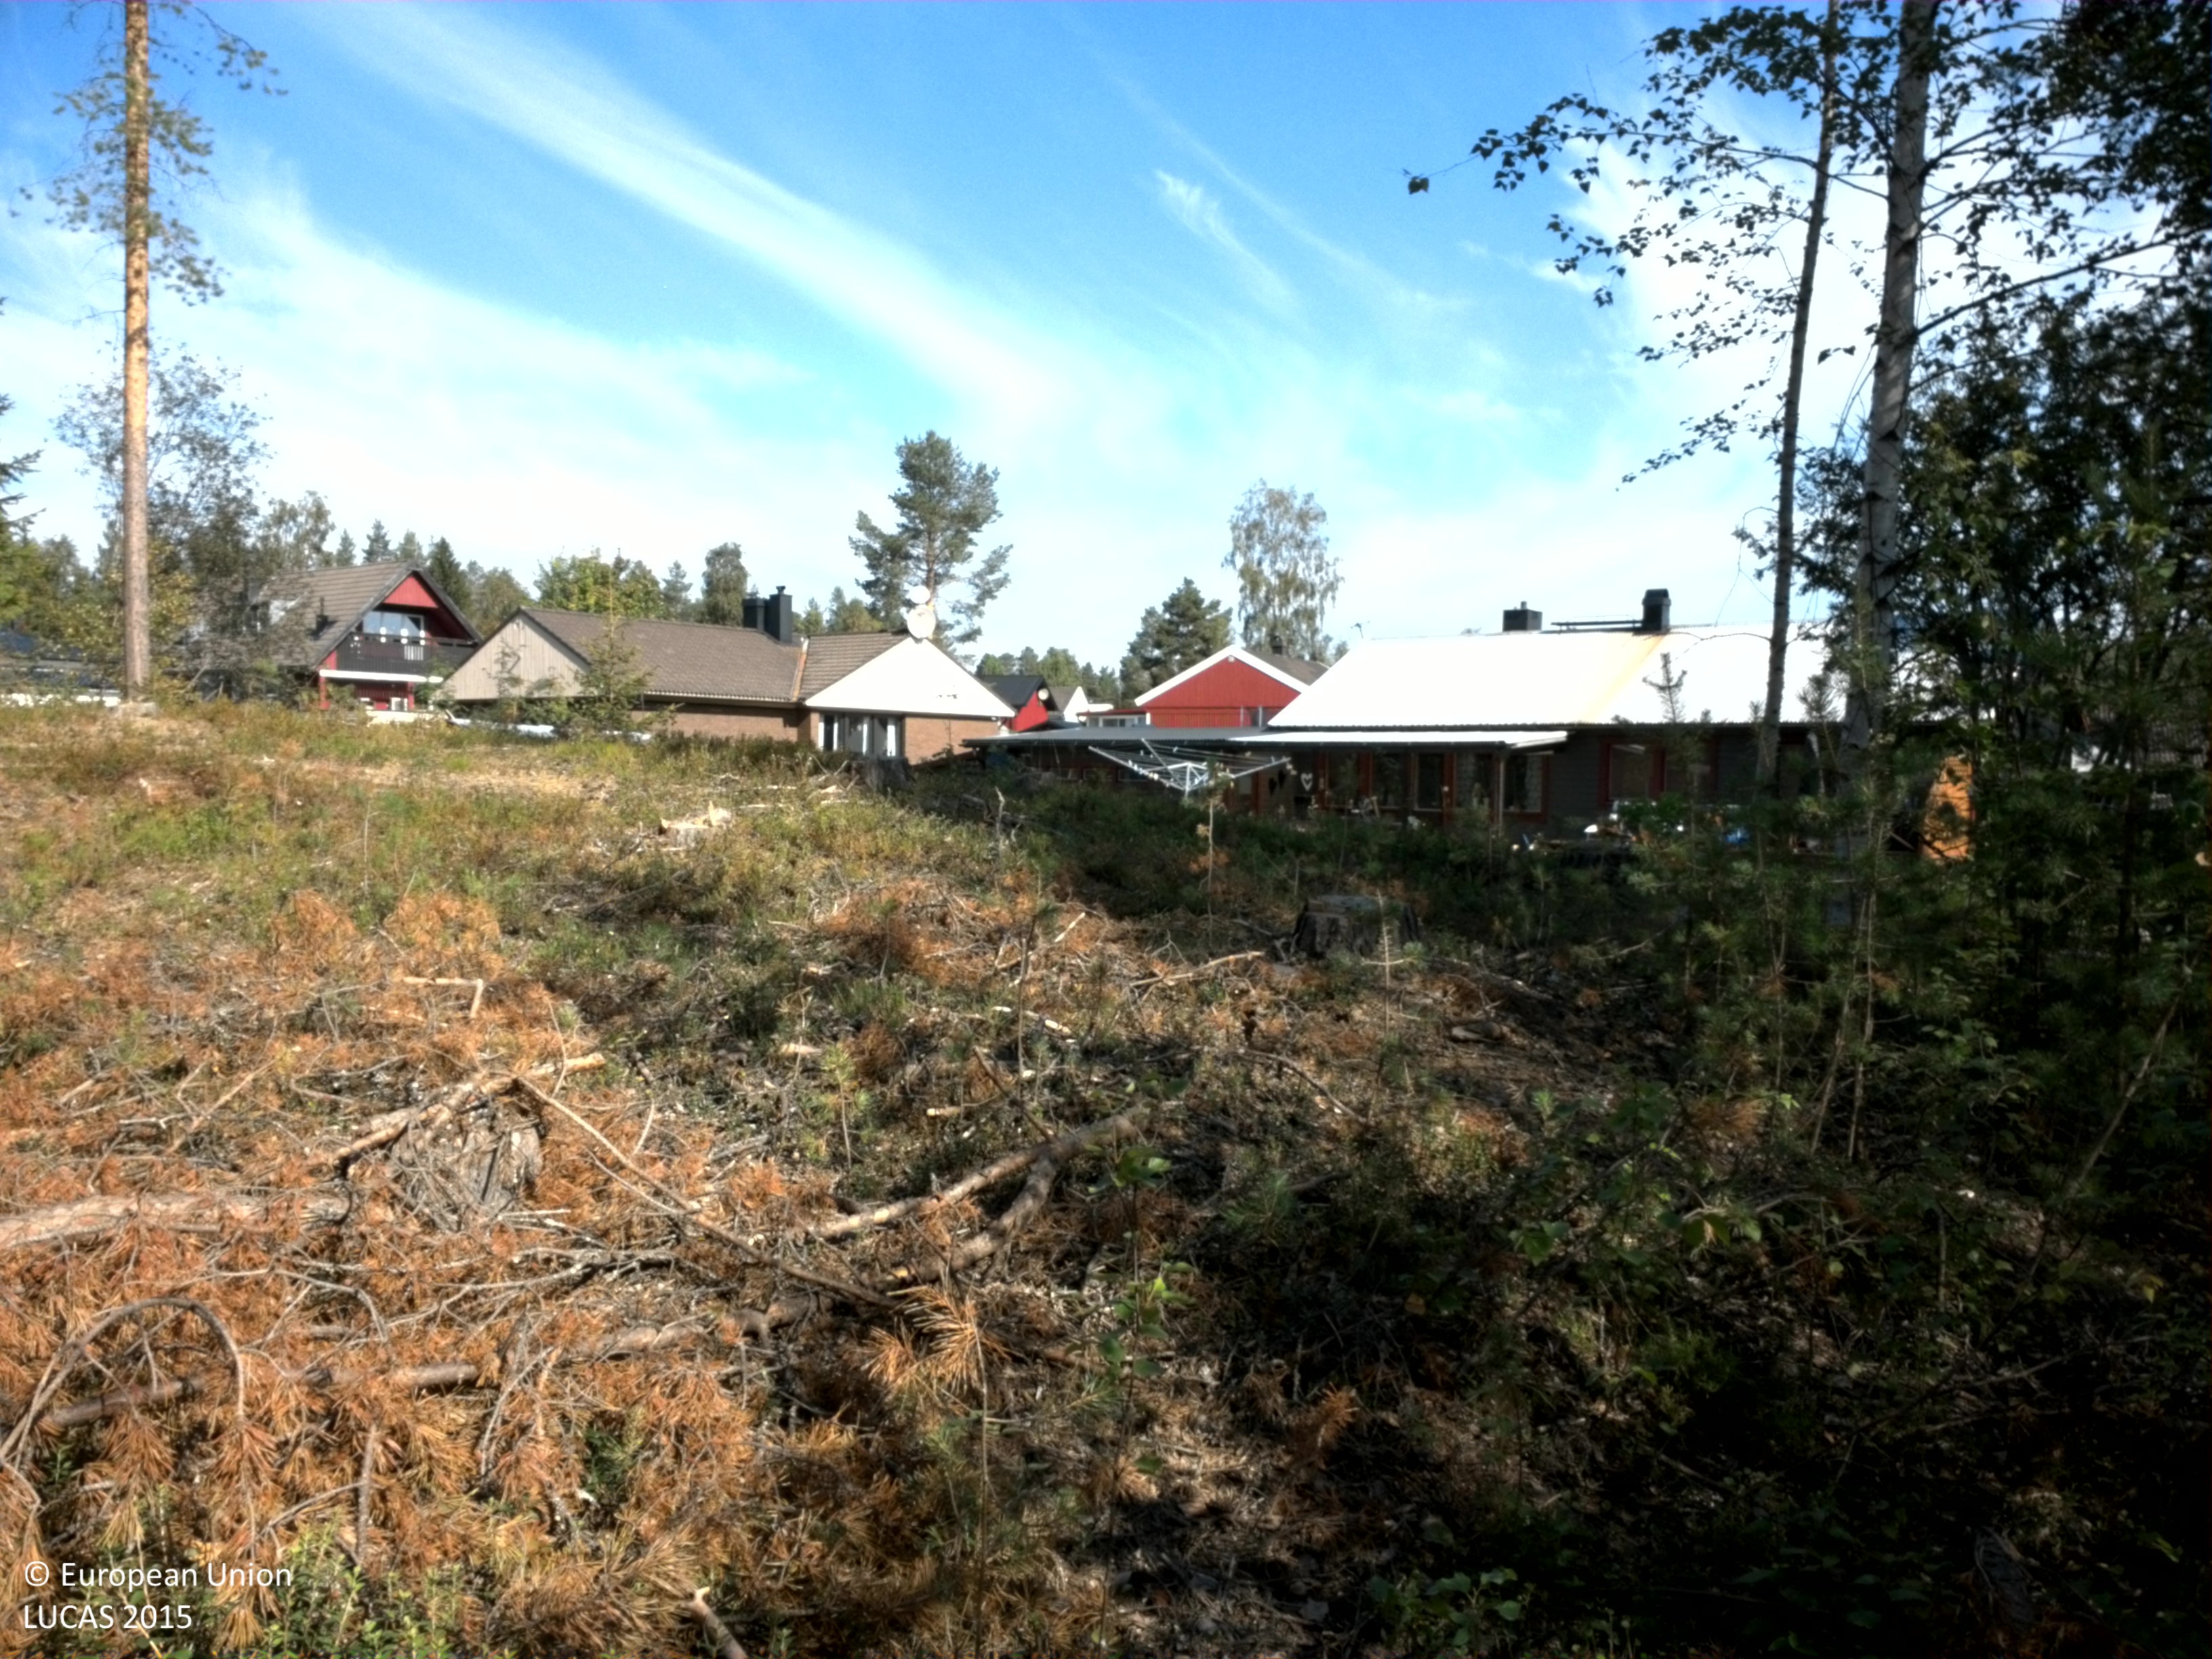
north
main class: Shrubland
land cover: Shrubland without tree cover
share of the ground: > 75 %
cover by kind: shrubs 100 %
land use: Forestry
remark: Clear cut
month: August
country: SE
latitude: 64.5766
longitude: 18.7157
